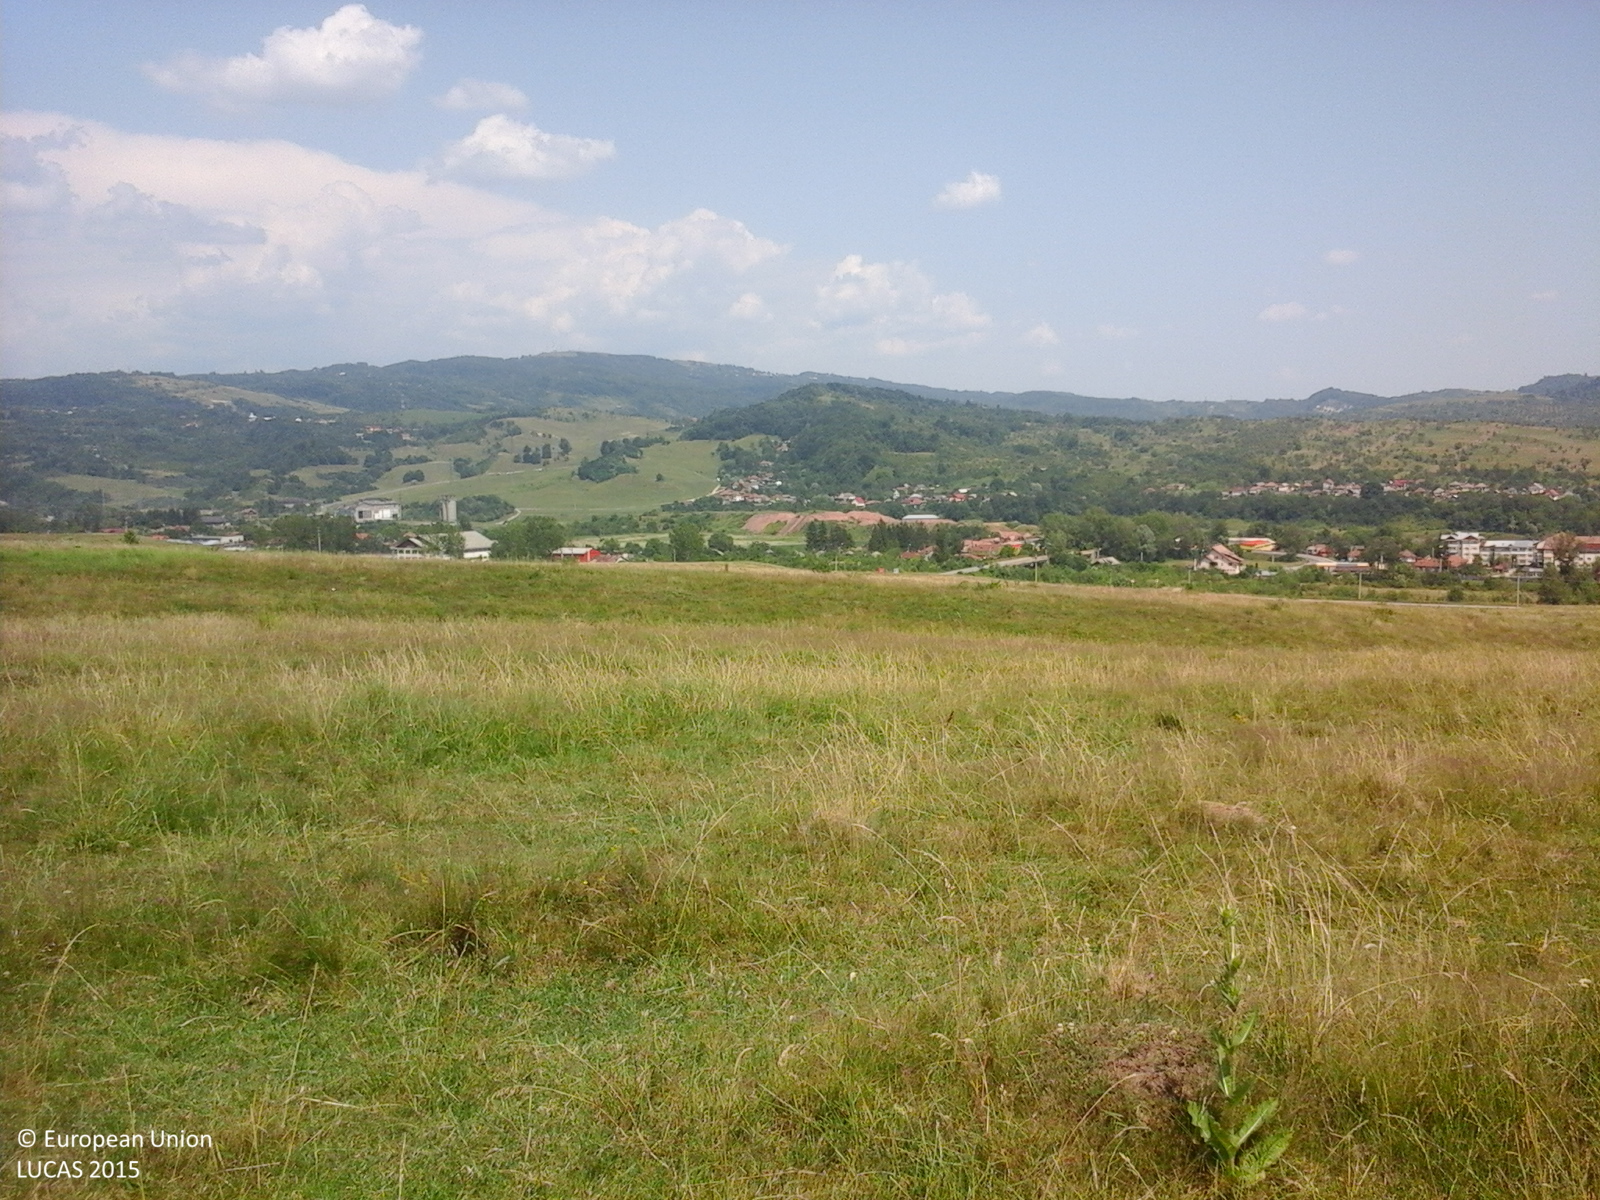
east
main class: Grassland
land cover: Grassland without tree/shrub cover
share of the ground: > 75 %
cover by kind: herbaceous plants 100 %
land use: Agriculture (excluding fallow land and kitchen gardens)
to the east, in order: Grassland without tree/shrub cover; Electric lines; Grassland without tree/shrub cover; Ditches and canals
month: July
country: RO
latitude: 45.2130
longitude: 24.9978
